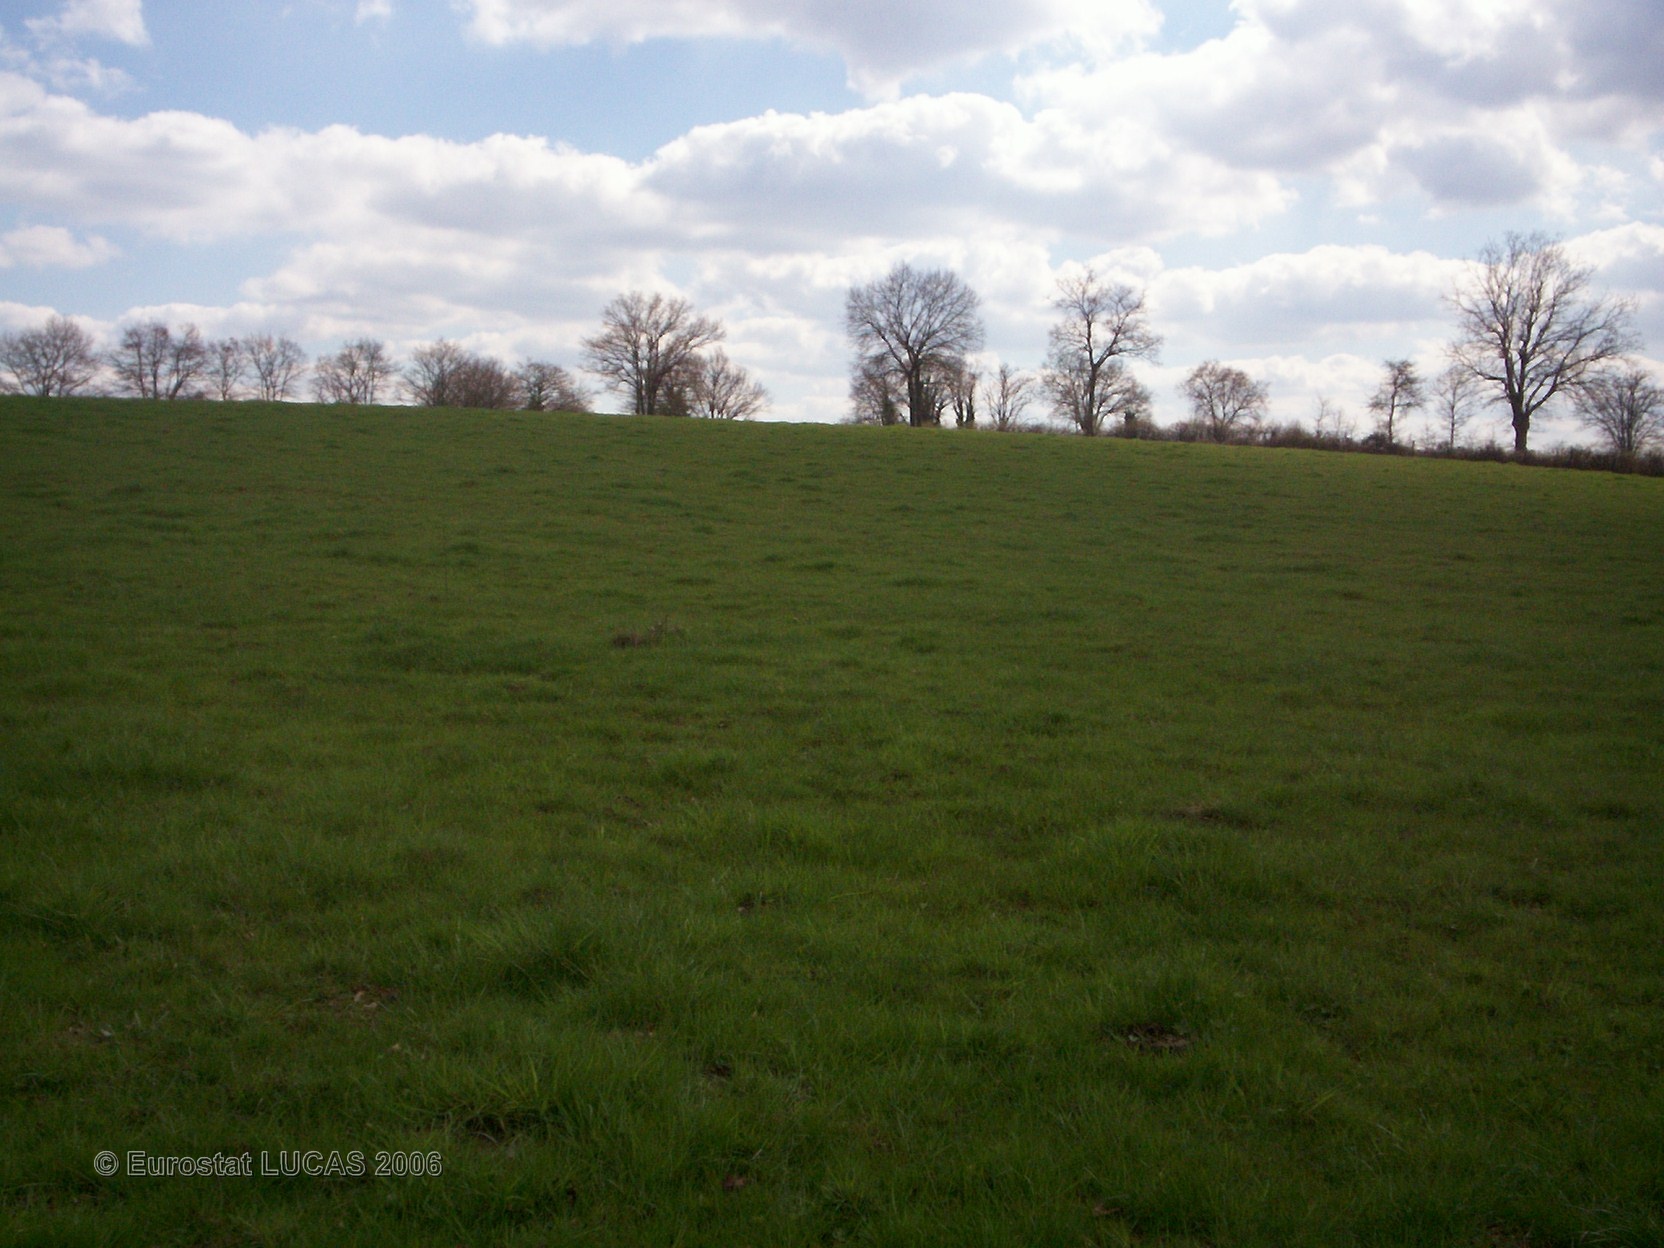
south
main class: Grassland
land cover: Grassland without tree/shrub cover
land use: Agriculture (excluding fallow land and kitchen gardens)
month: April
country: FR
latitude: 46.7802
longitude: 3.1205
